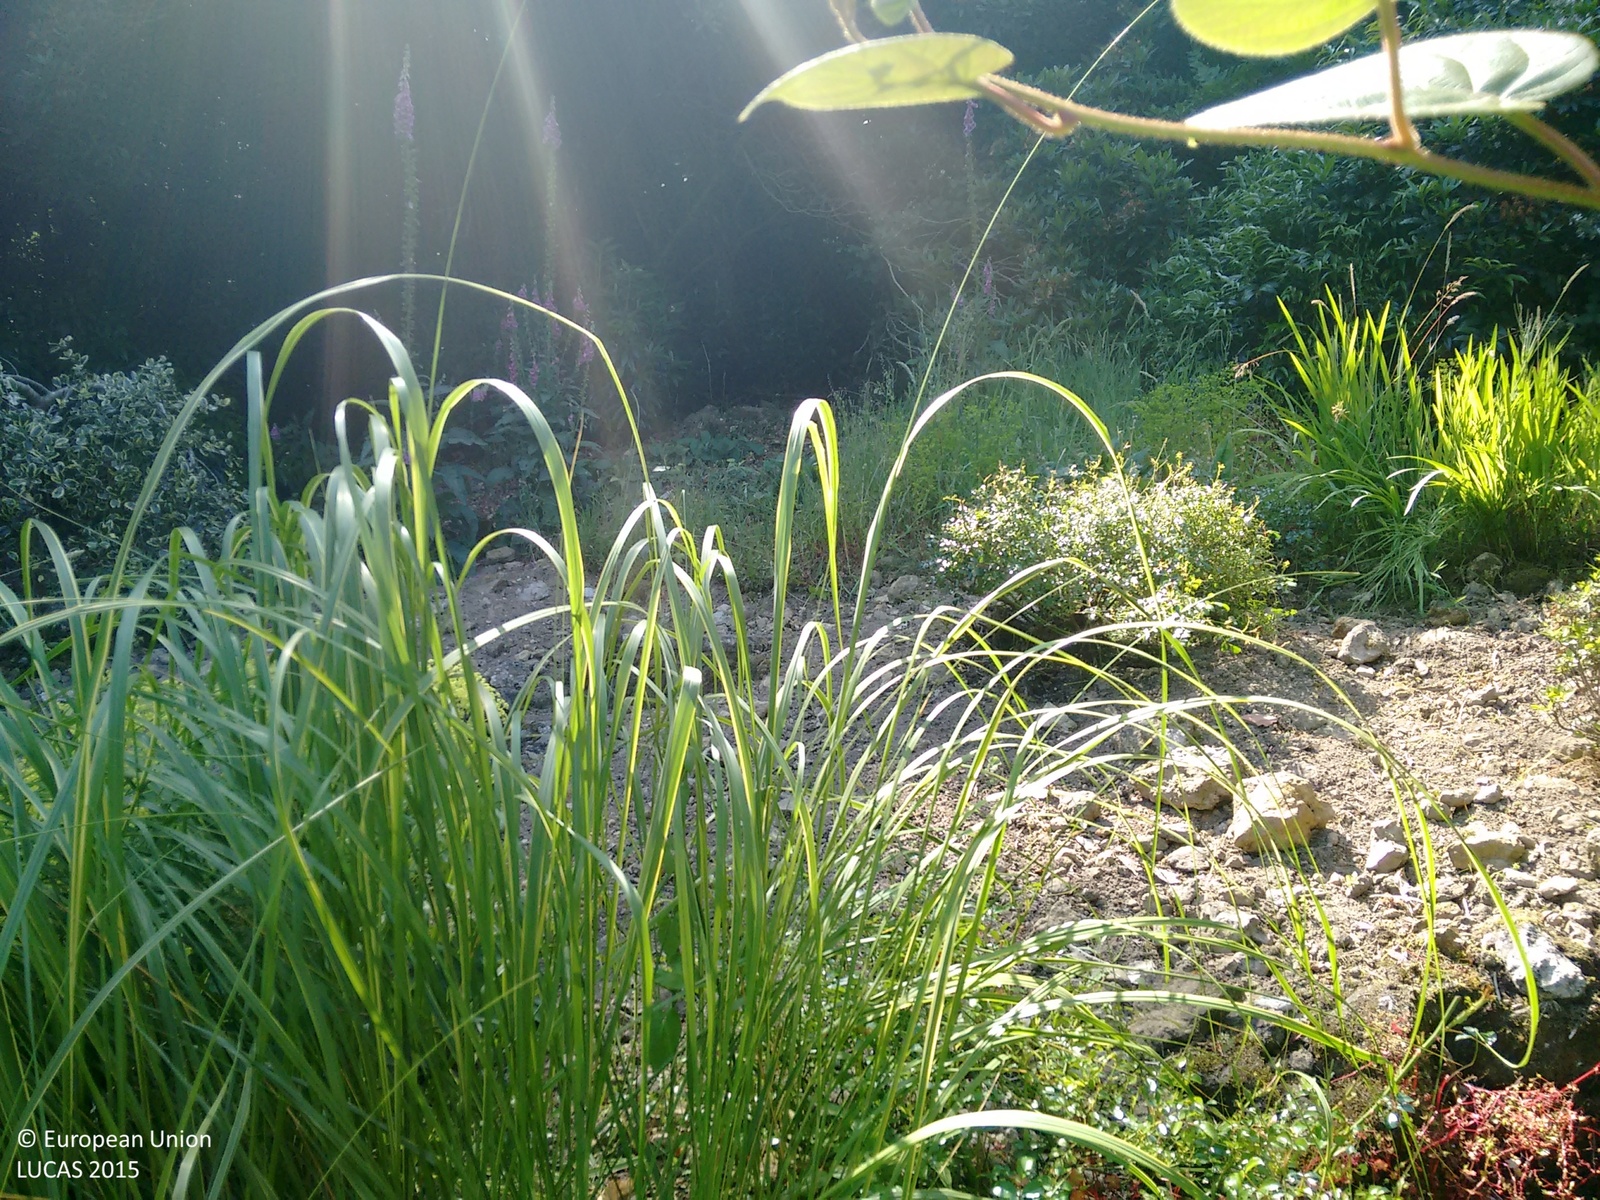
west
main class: Grassland
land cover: Grassland with sparse tree/shrub cover
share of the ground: > 75 %
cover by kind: herbaceous plants 95 %, broadleaved forest trees 5 %
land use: Residential
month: July
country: GB
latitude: 51.1702
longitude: -0.4643
